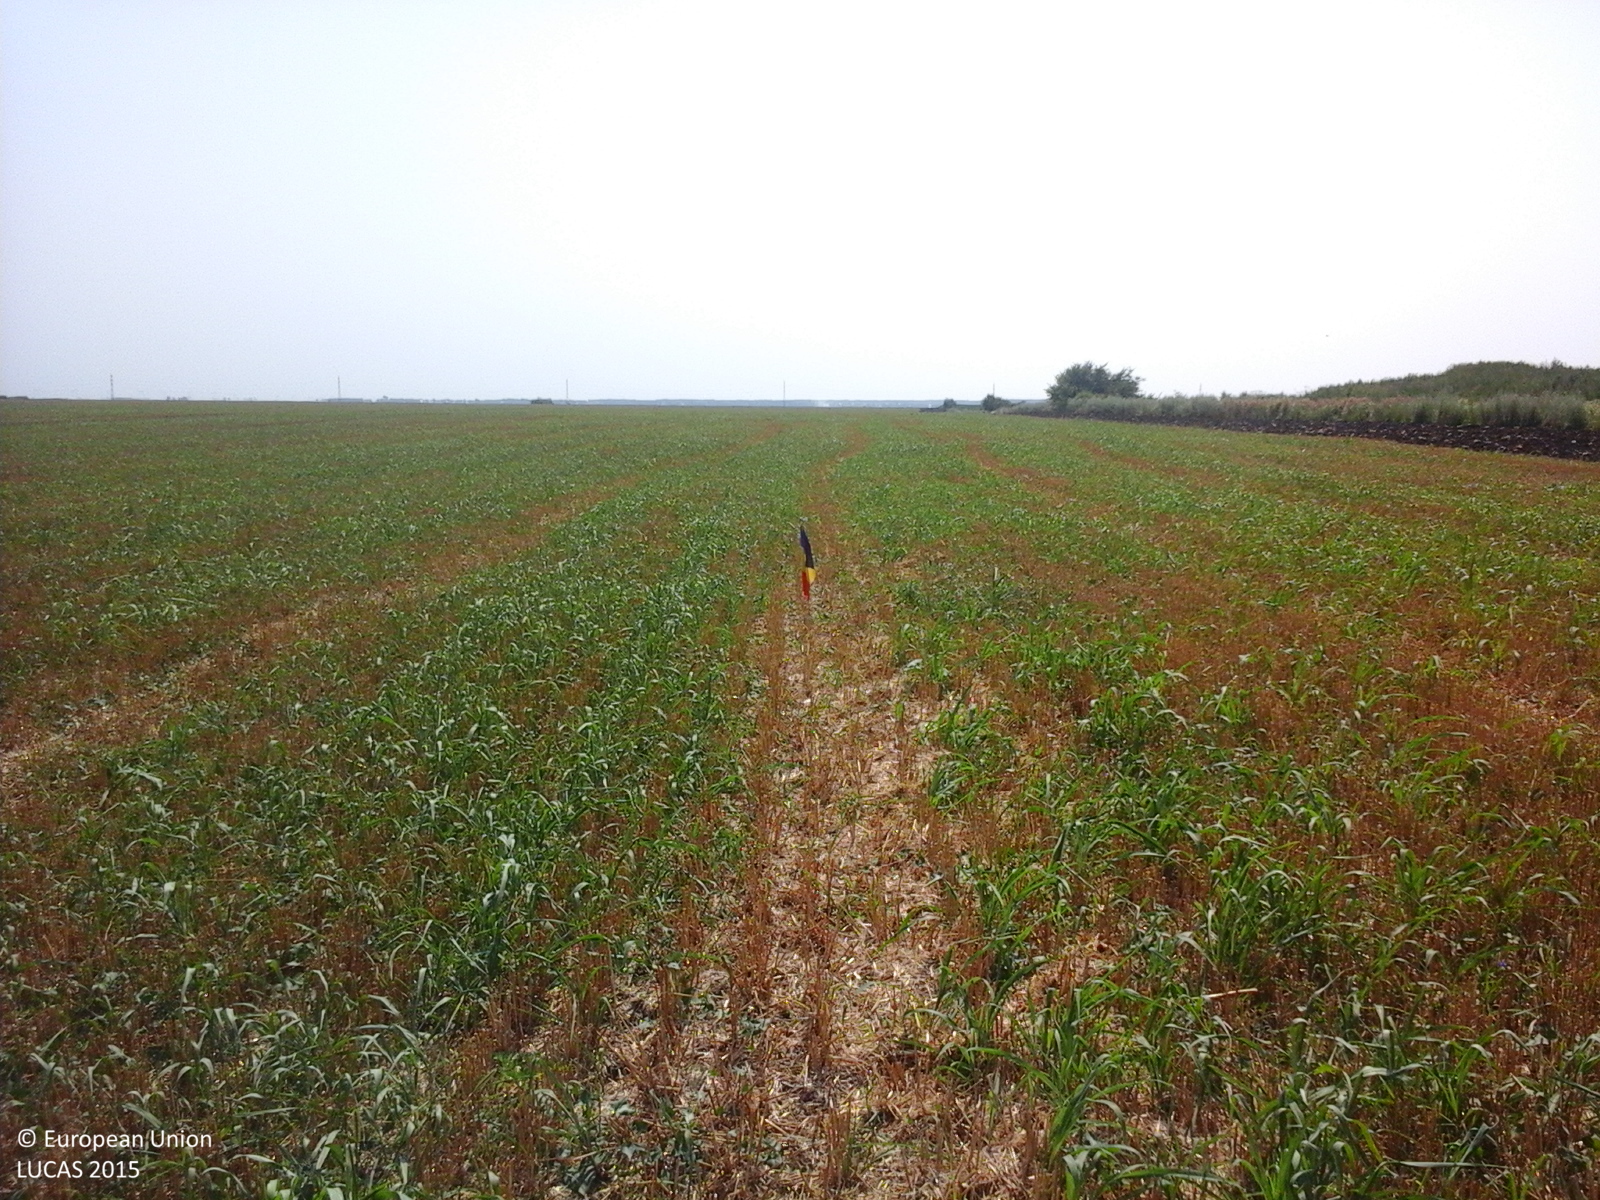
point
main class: Cropland
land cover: Durum wheat
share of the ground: 25 - 50 %
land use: Agriculture (excluding fallow land and kitchen gardens)
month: July
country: RO
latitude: 44.5375
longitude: 26.5406
